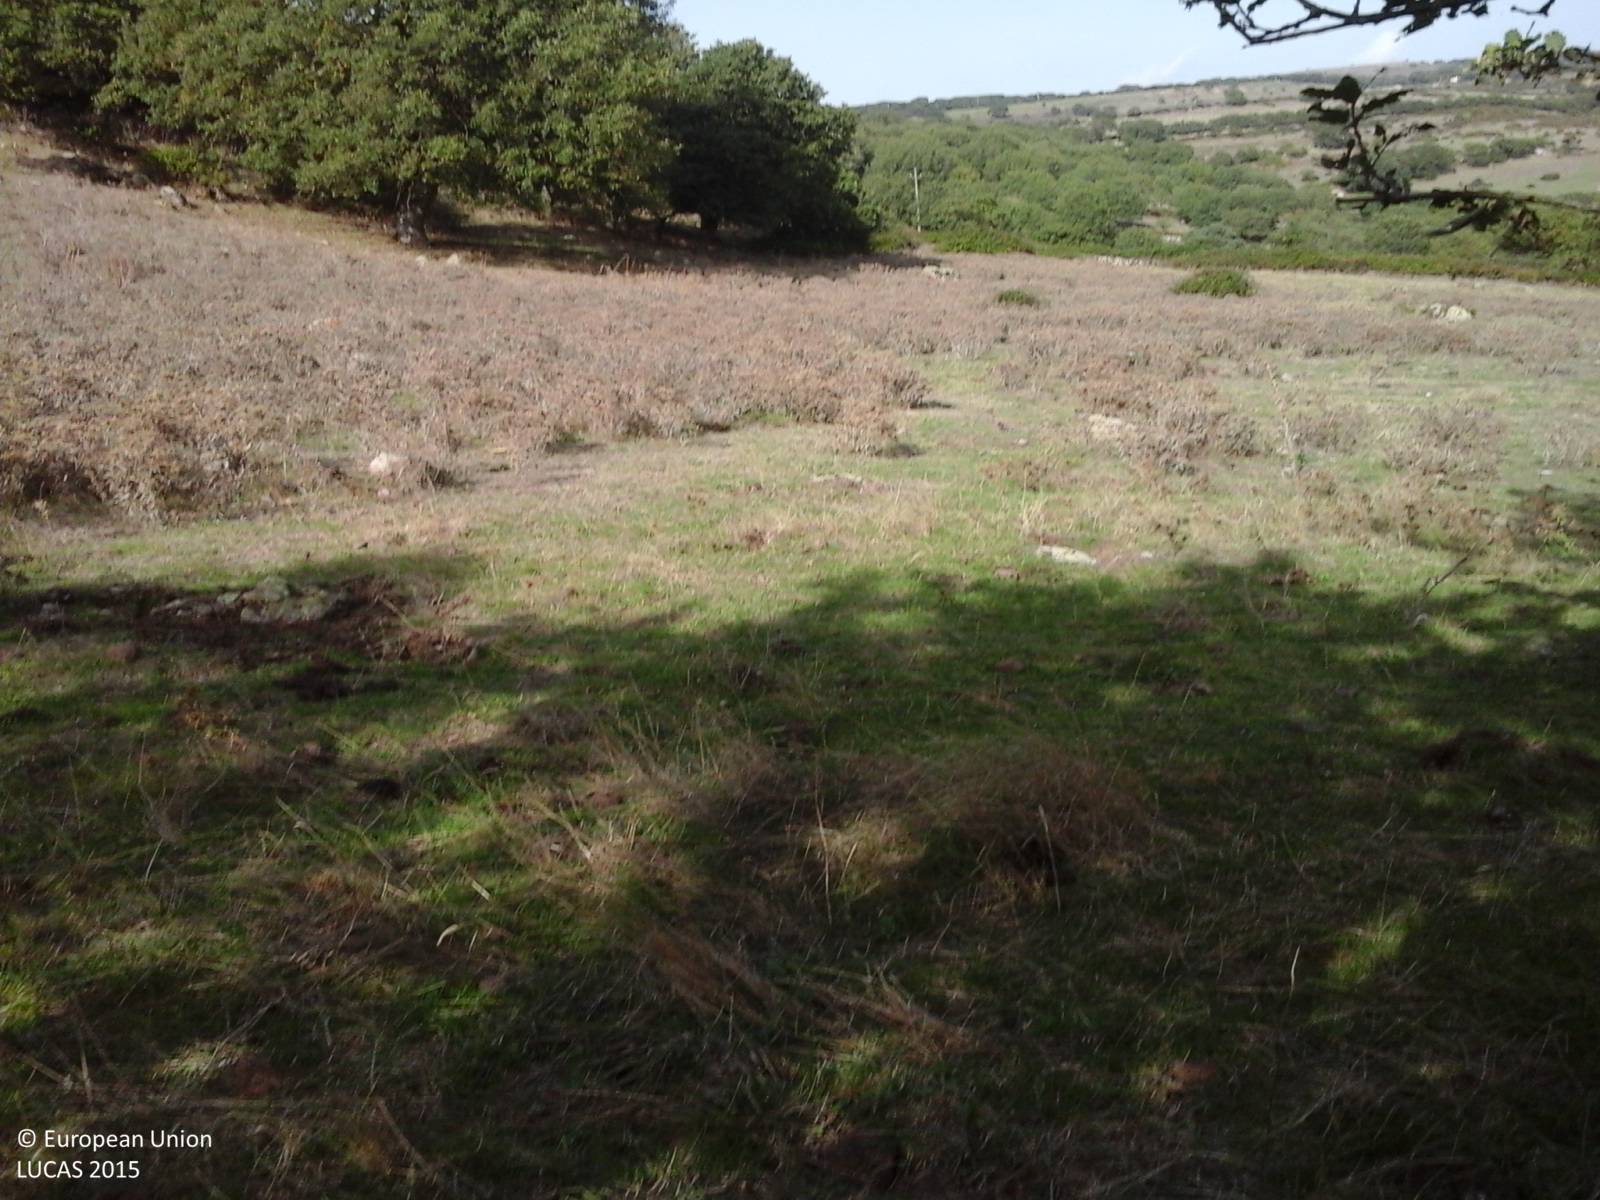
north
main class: Grassland
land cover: Grassland without tree/shrub cover
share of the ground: 25 - 50 %
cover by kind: herbaceous plants 100 %
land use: Agriculture (excluding fallow land and kitchen gardens)
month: October
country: IT
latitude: 40.2964
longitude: 8.8180
